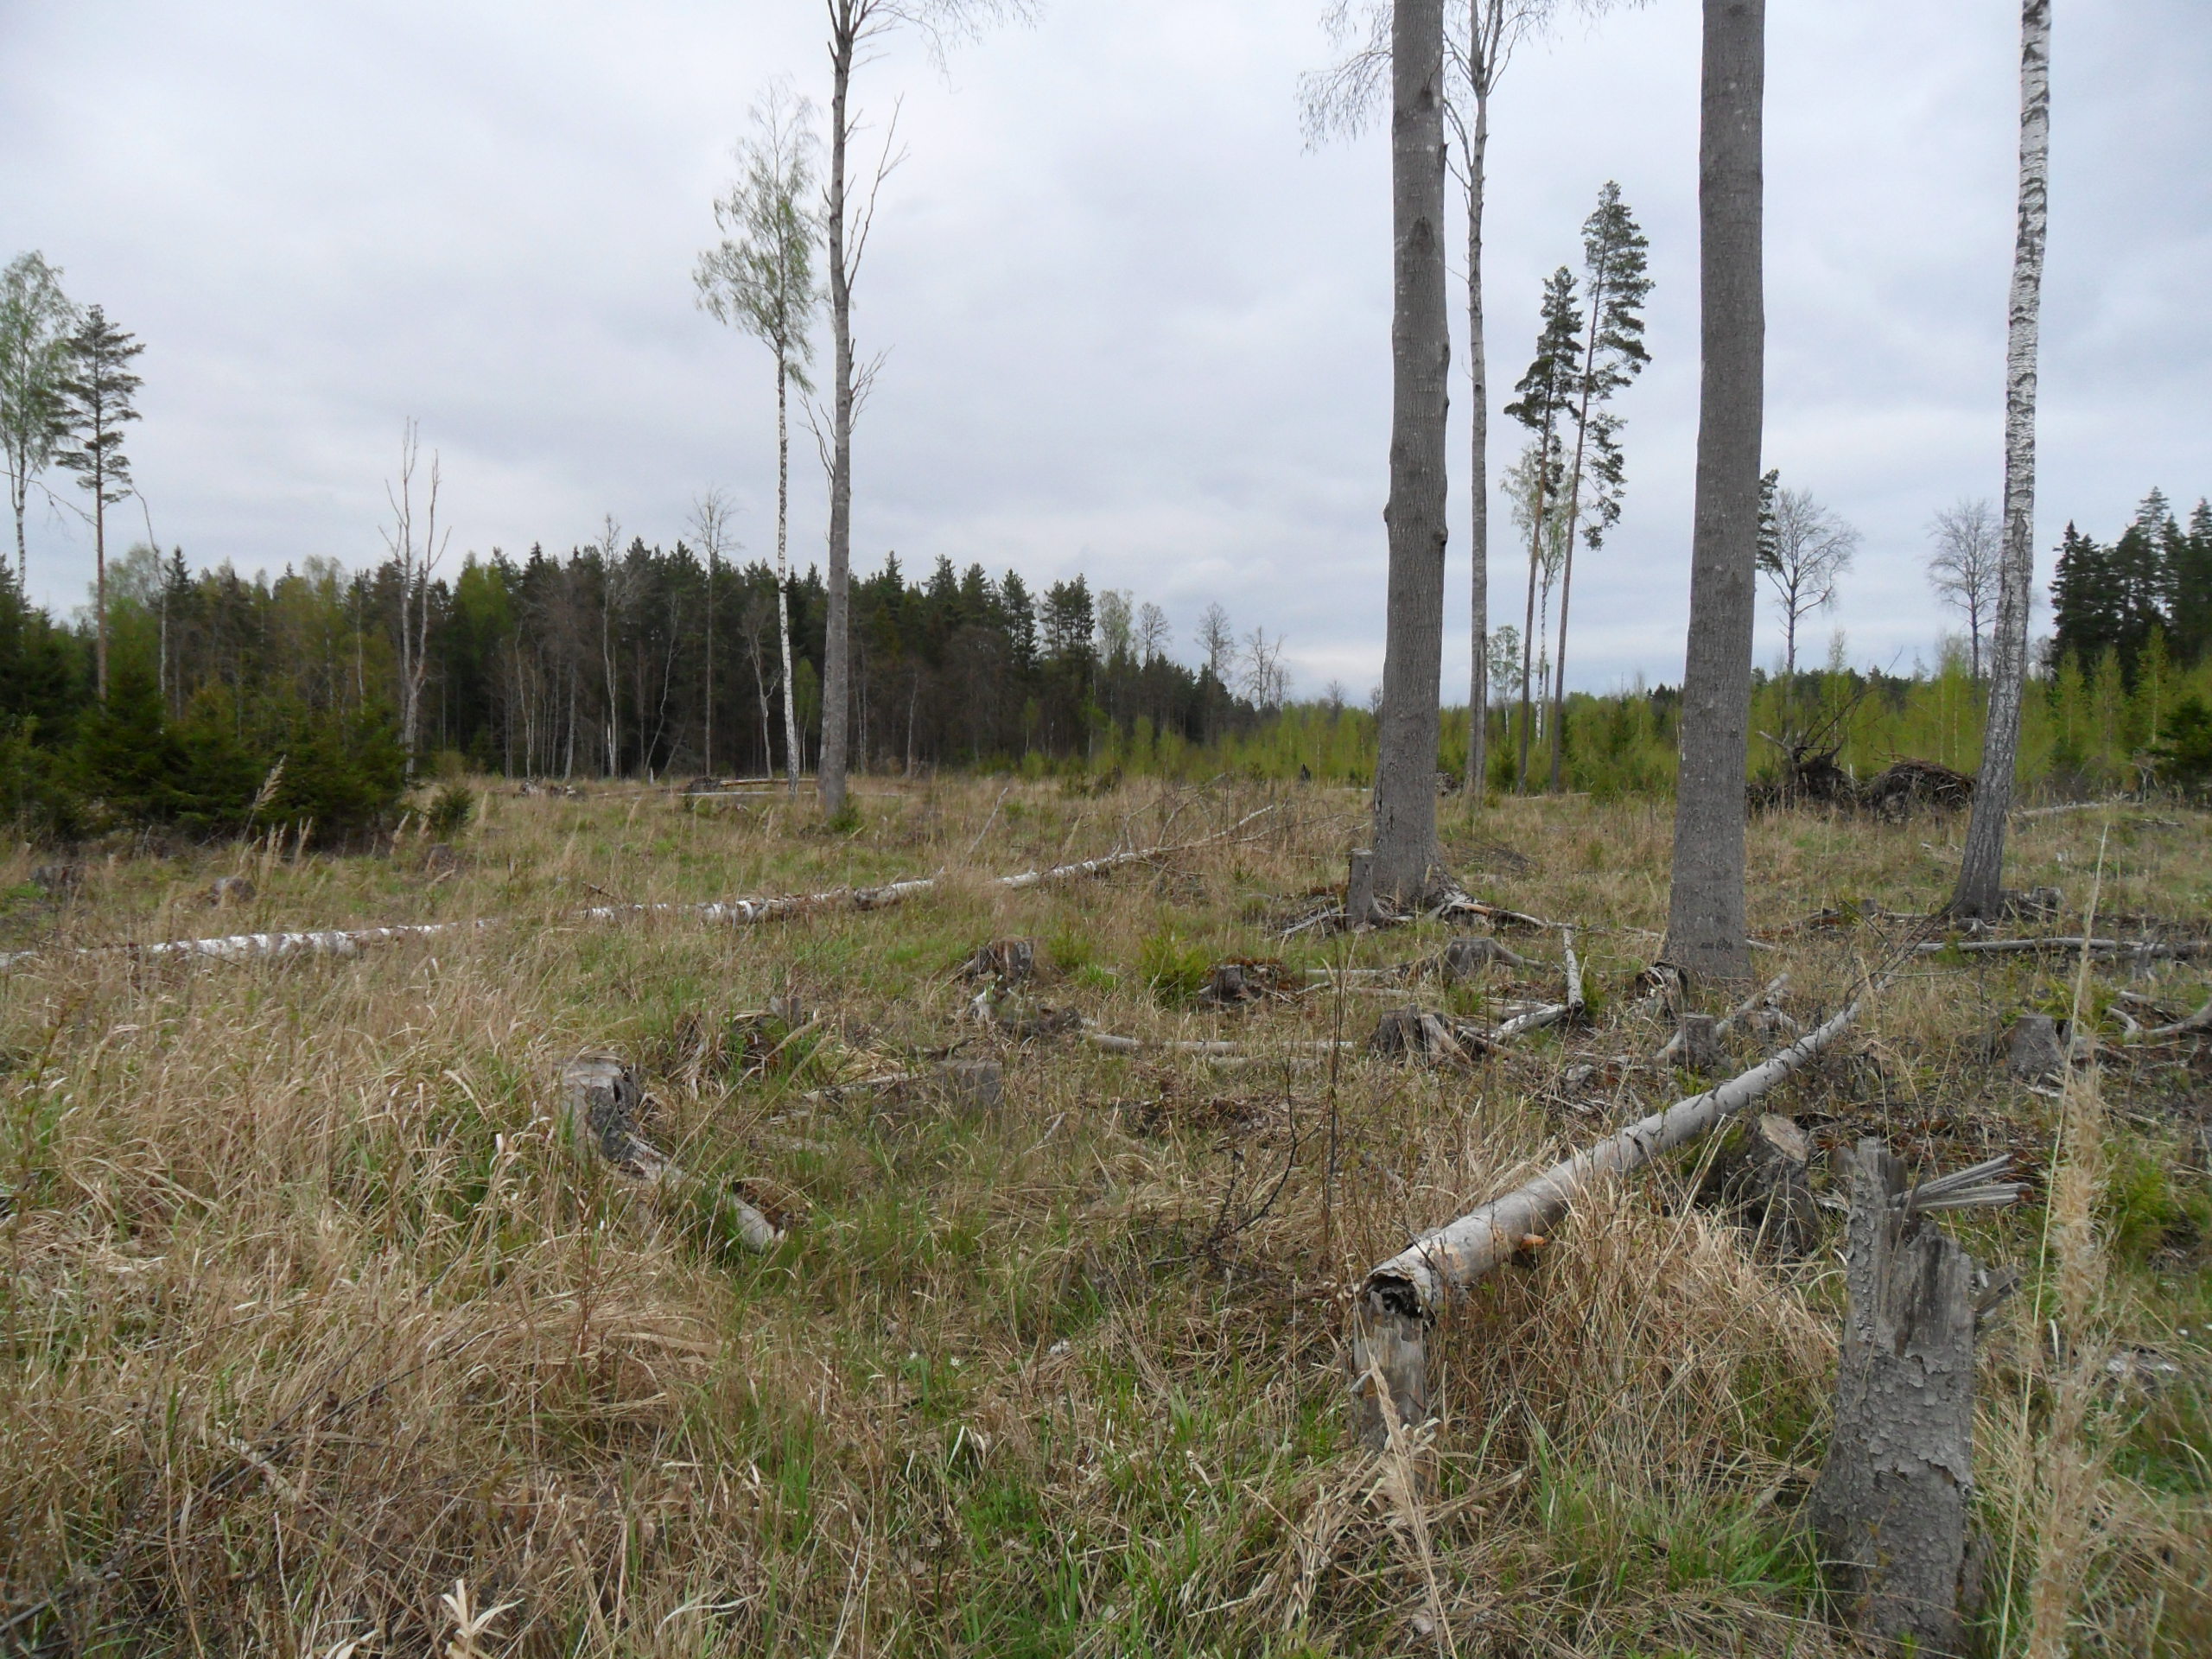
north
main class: Grassland
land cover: Grassland with sparse tree/shrub cover
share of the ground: > 75 %
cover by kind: herbaceous plants 90 %, coniferous forest trees 5 %, shrubs 5 %
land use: Forestry
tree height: < 5 m
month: May
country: LV
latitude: 57.2166
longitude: 23.0288
